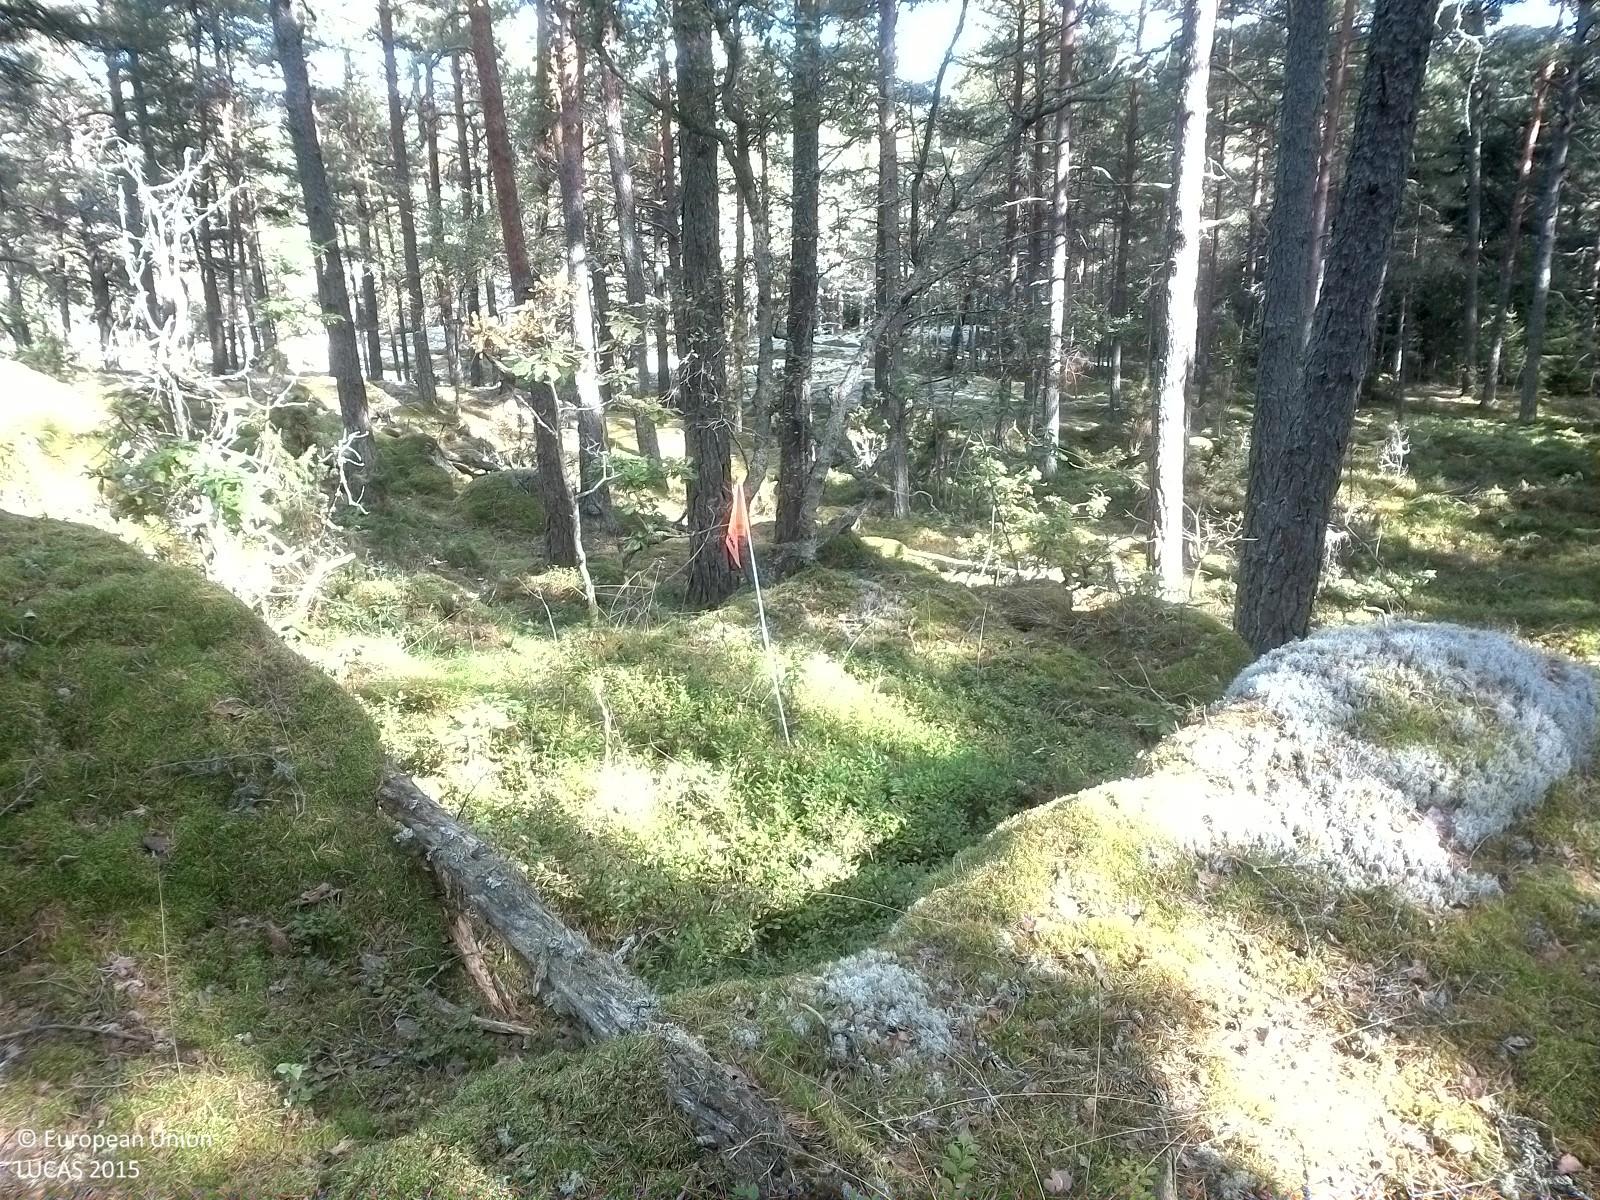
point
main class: Woodland
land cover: Pine dominated coniferous woodland
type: boreal forest
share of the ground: 25 - 50 %
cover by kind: herbaceous plants 55 %, coniferous forest trees 25 %, lichens and mosses 15 %, broadleaved forest trees 5 %
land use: Forestry
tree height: > 5 m
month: September
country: SE
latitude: 58.5232
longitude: 16.2971
